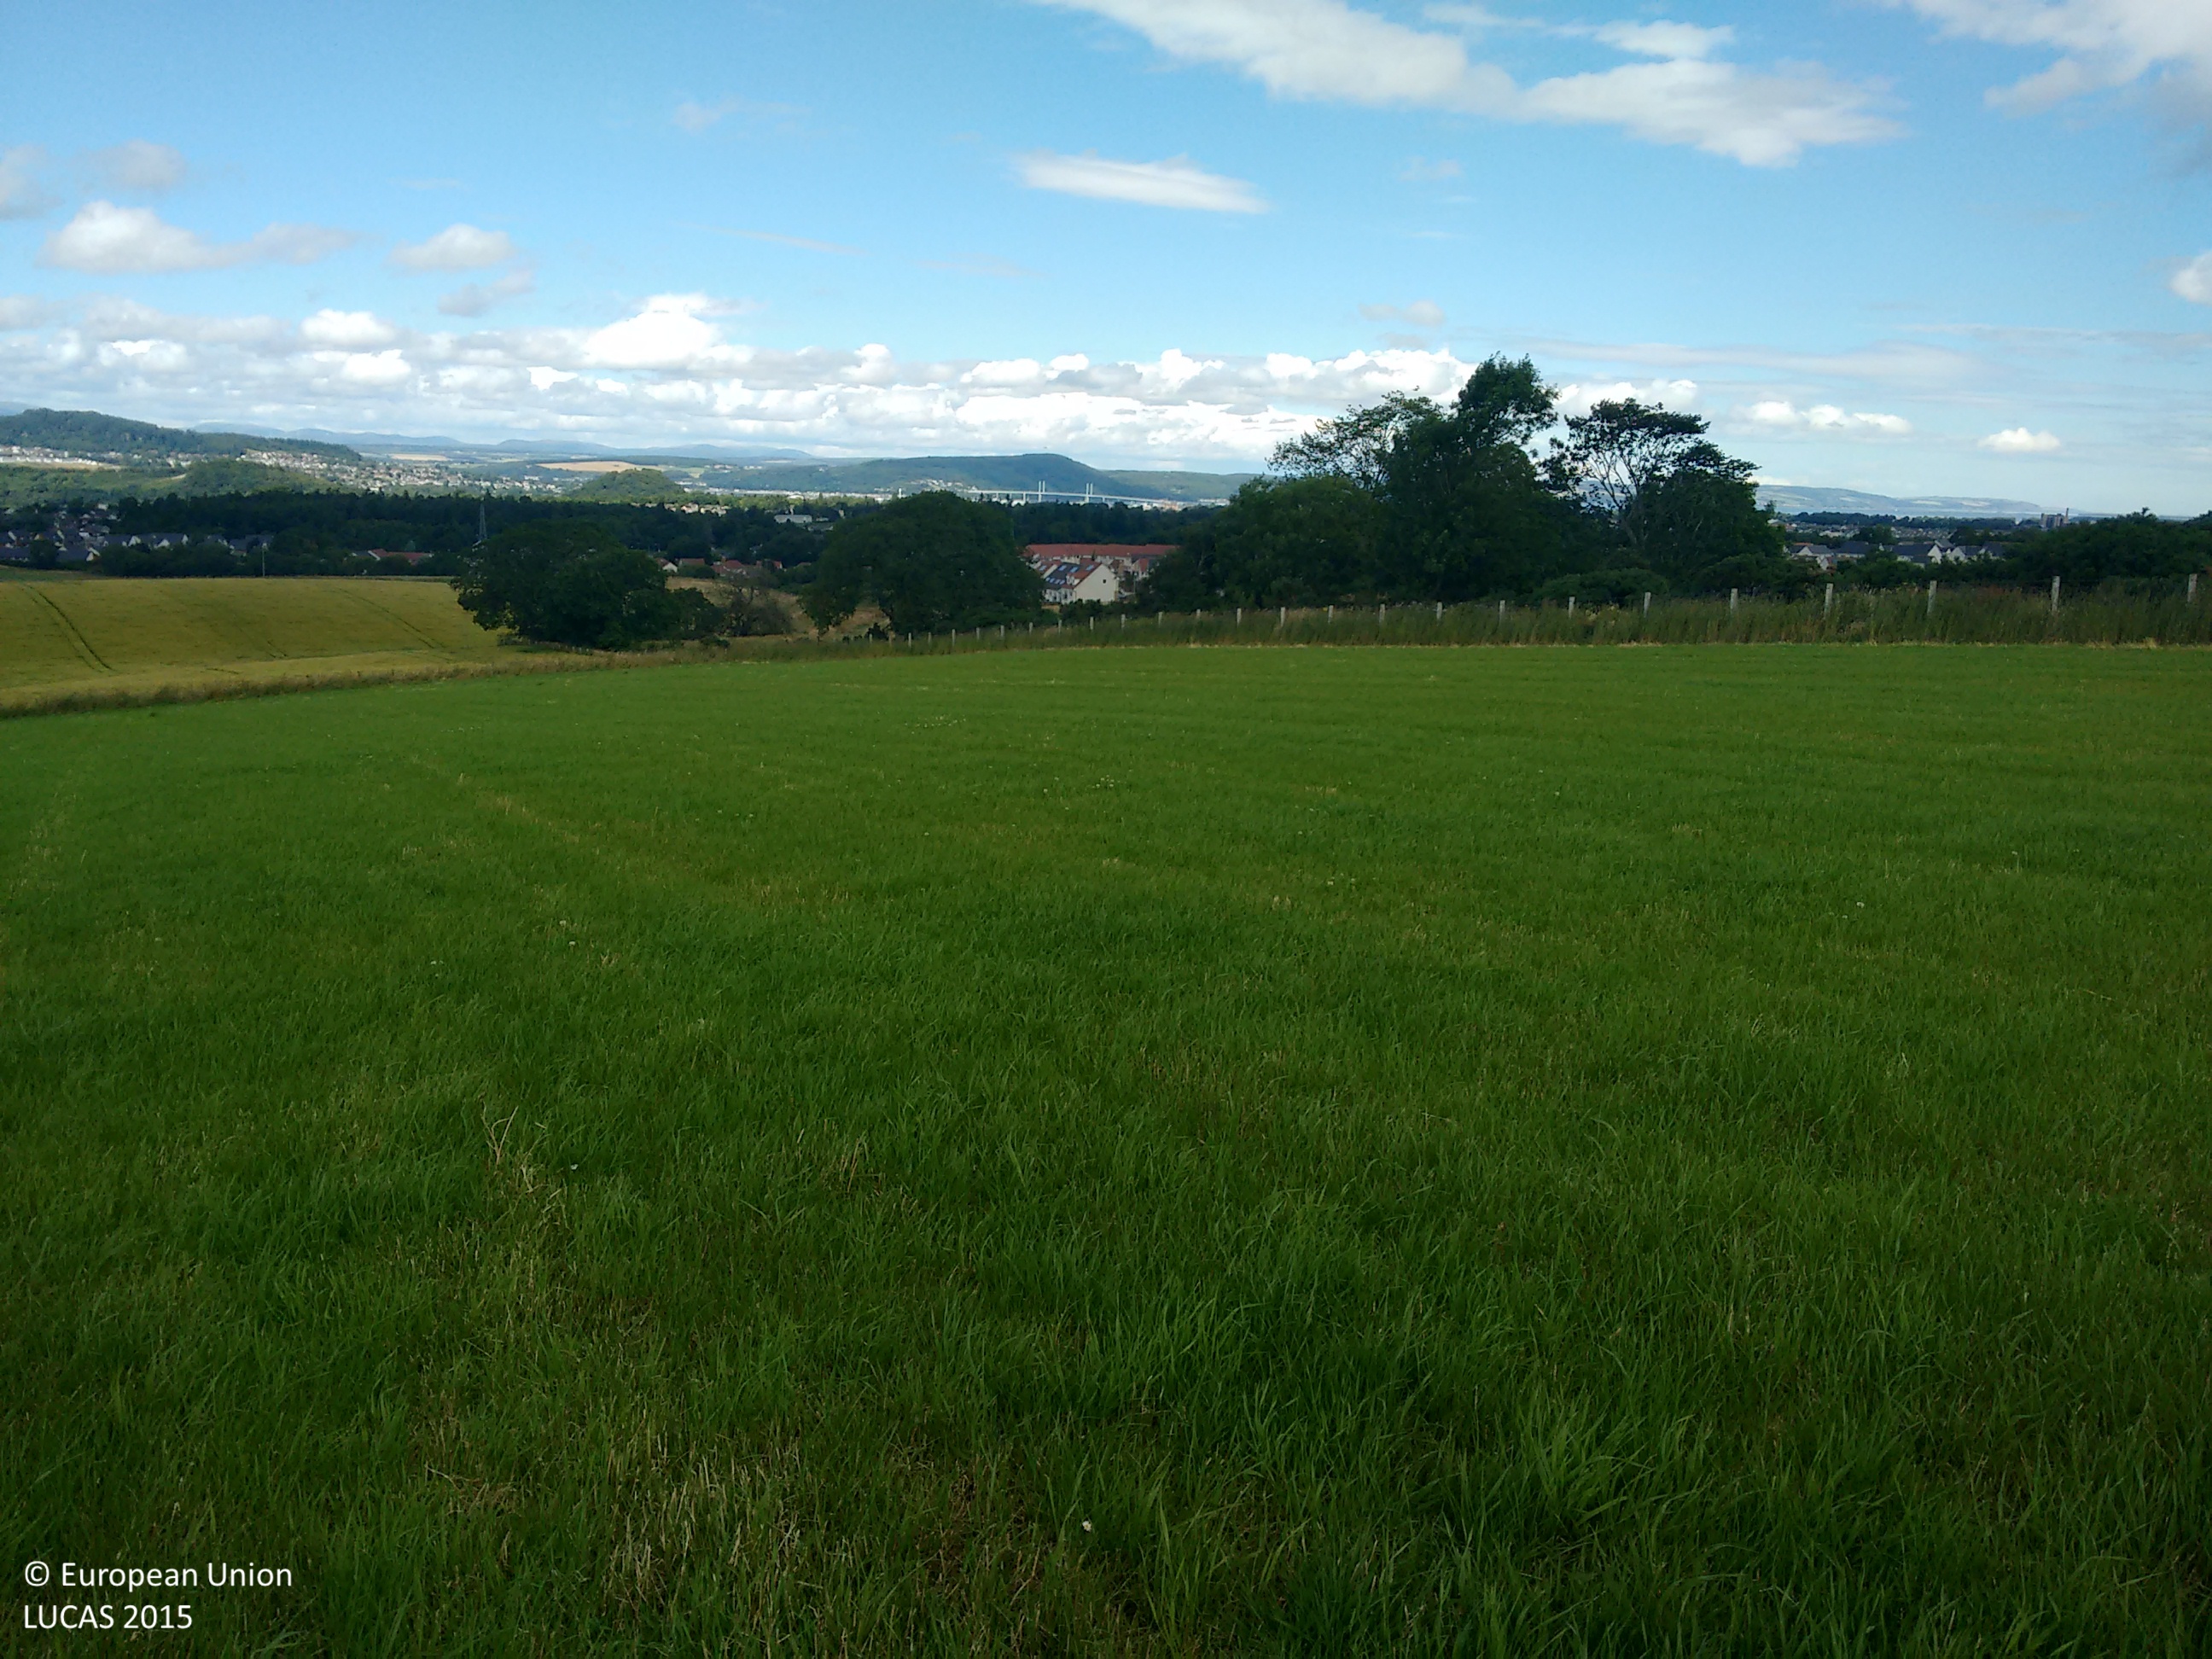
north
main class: Grassland
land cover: Grassland without tree/shrub cover
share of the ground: > 75 %
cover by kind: herbaceous plants 100 %
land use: Agriculture (excluding fallow land and kitchen gardens)
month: August
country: GB
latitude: 57.4386
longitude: -4.2291
